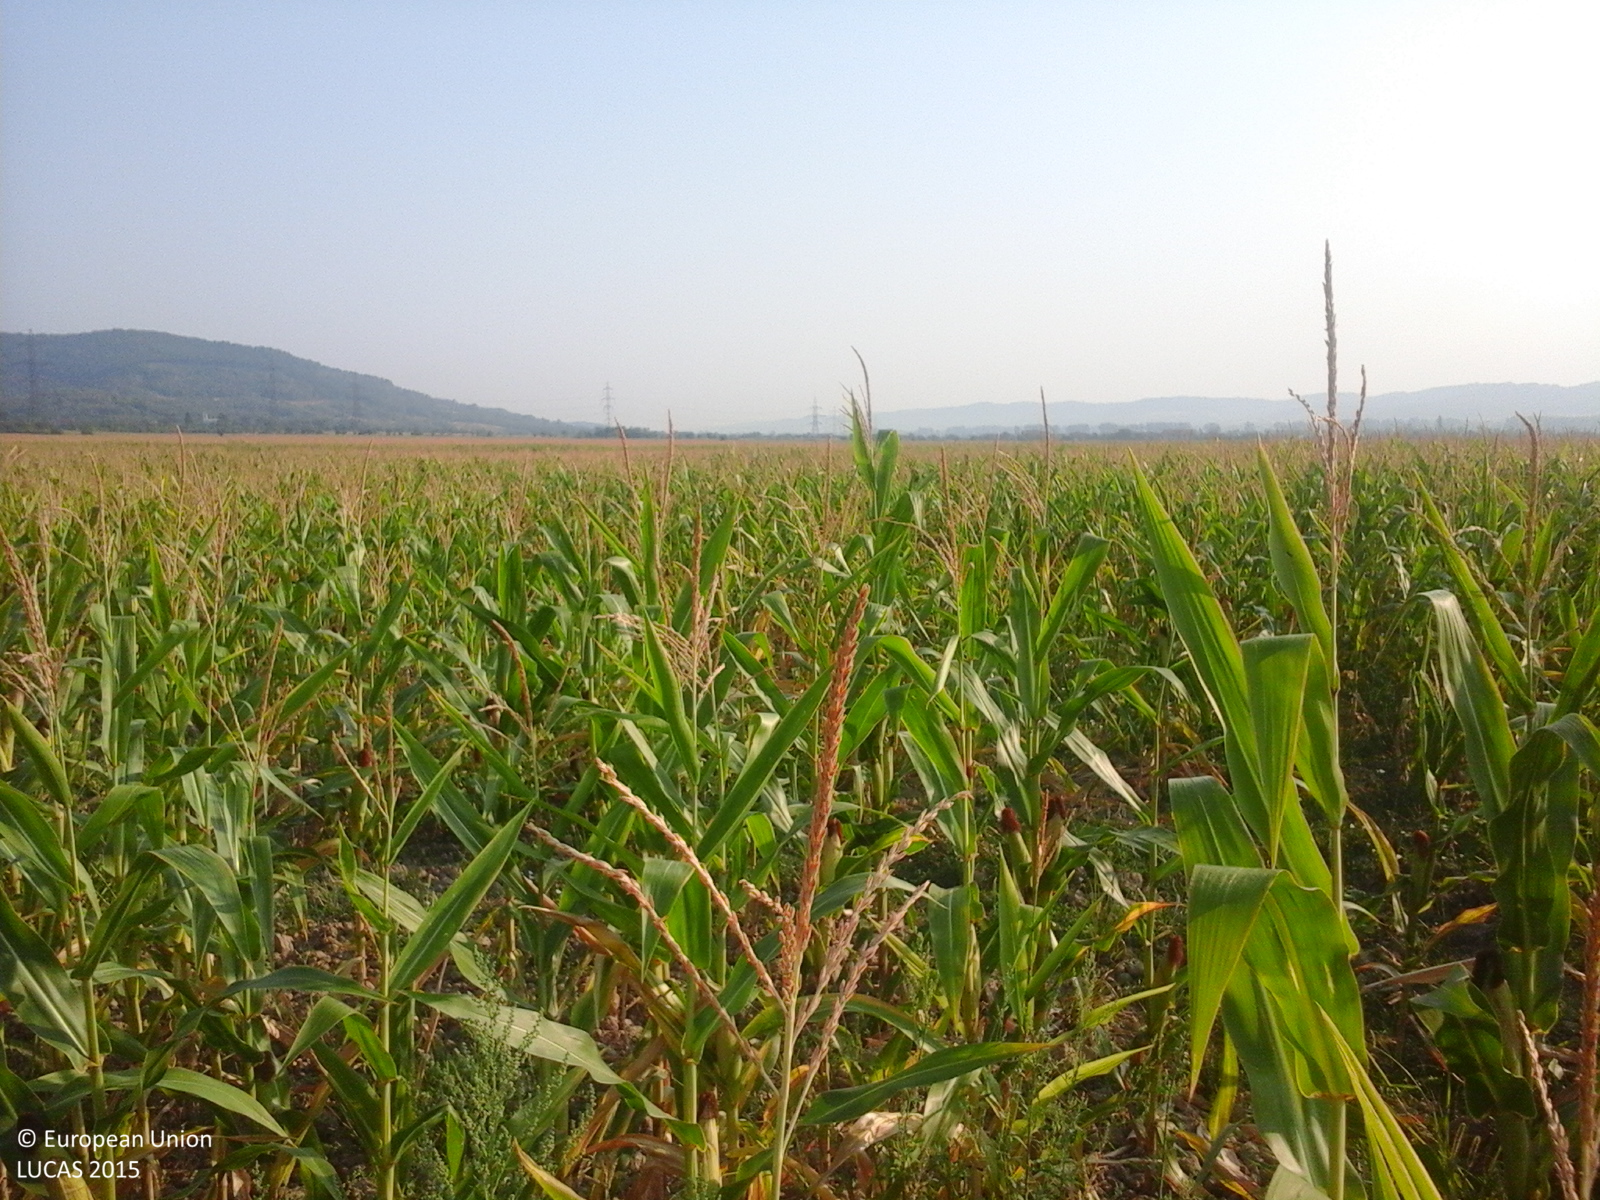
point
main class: Cropland
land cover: Maize
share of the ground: > 75 %
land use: Agriculture (excluding fallow land and kitchen gardens)
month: August
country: RO
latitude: 44.7624
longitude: 23.4849
